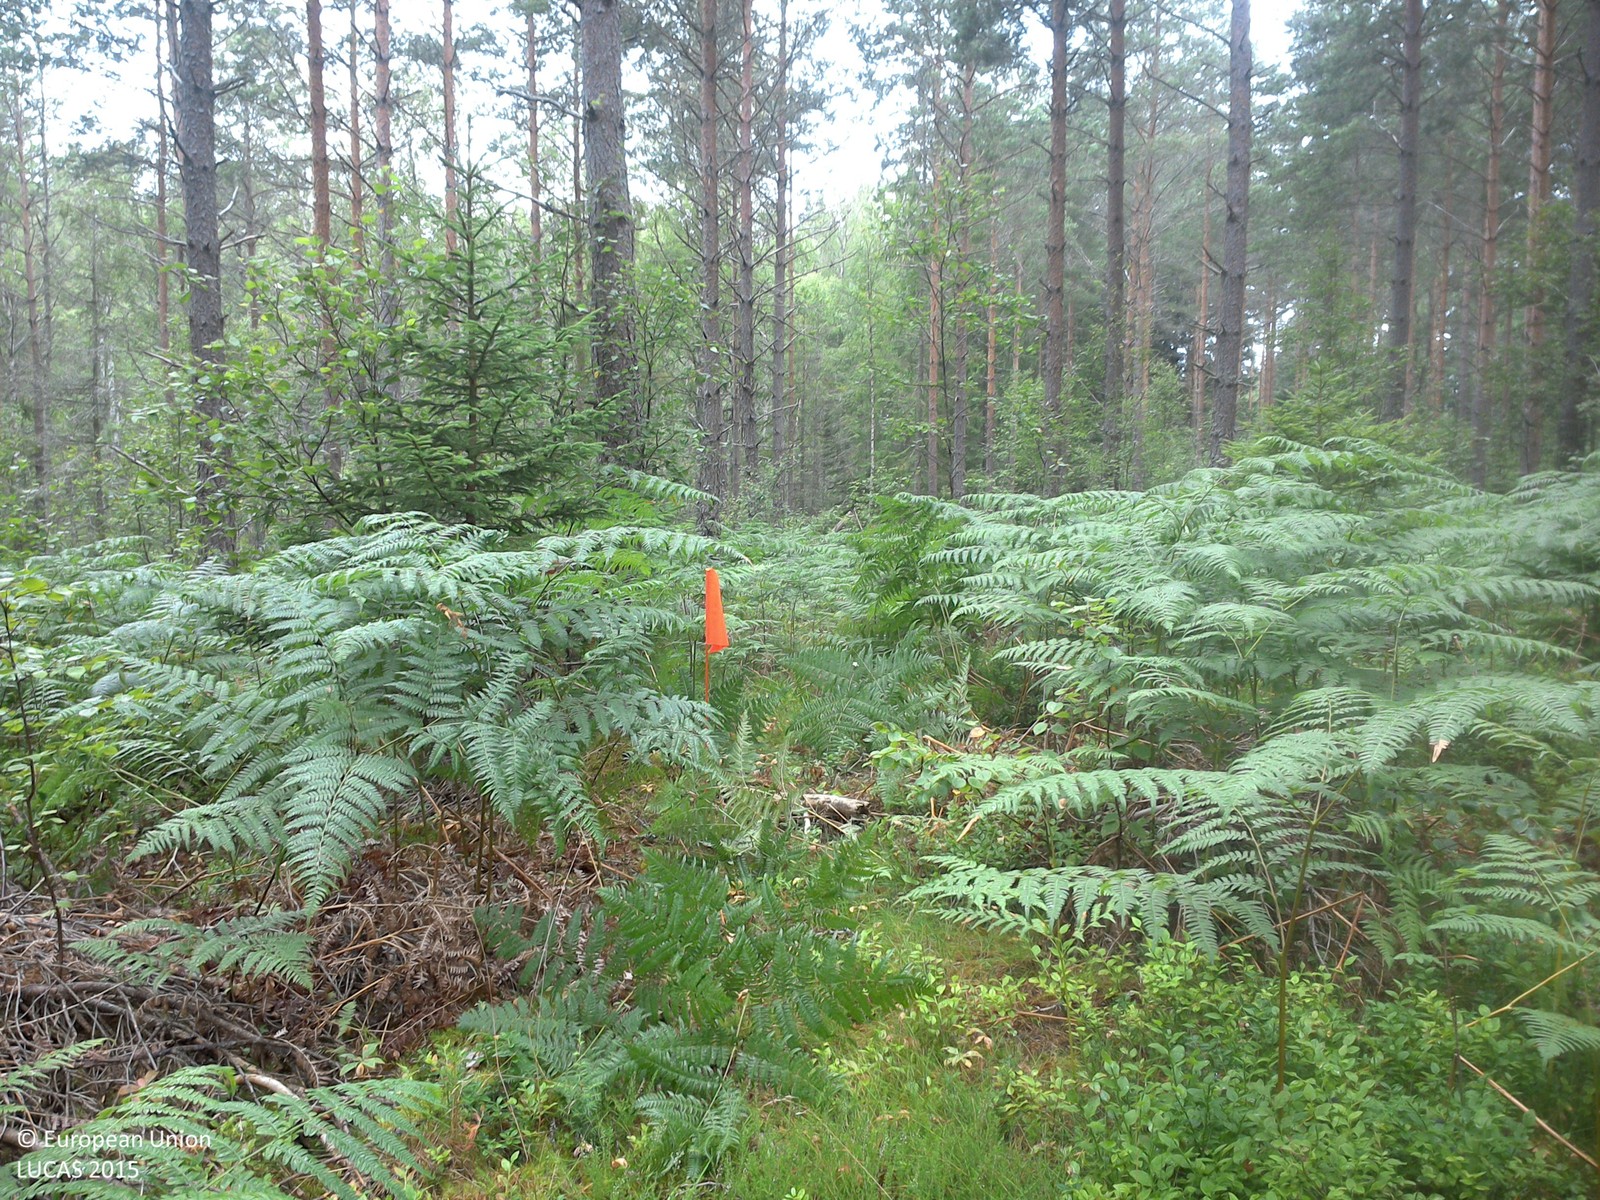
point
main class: Woodland
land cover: Pine dominated coniferous woodland
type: boreal forest
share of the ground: 25 - 50 %
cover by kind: herbaceous plants 50 %, coniferous forest trees 35 %, lichens and mosses 15 %
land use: Forestry
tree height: > 5 m
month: August
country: SE
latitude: 57.8253
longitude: 15.3332
